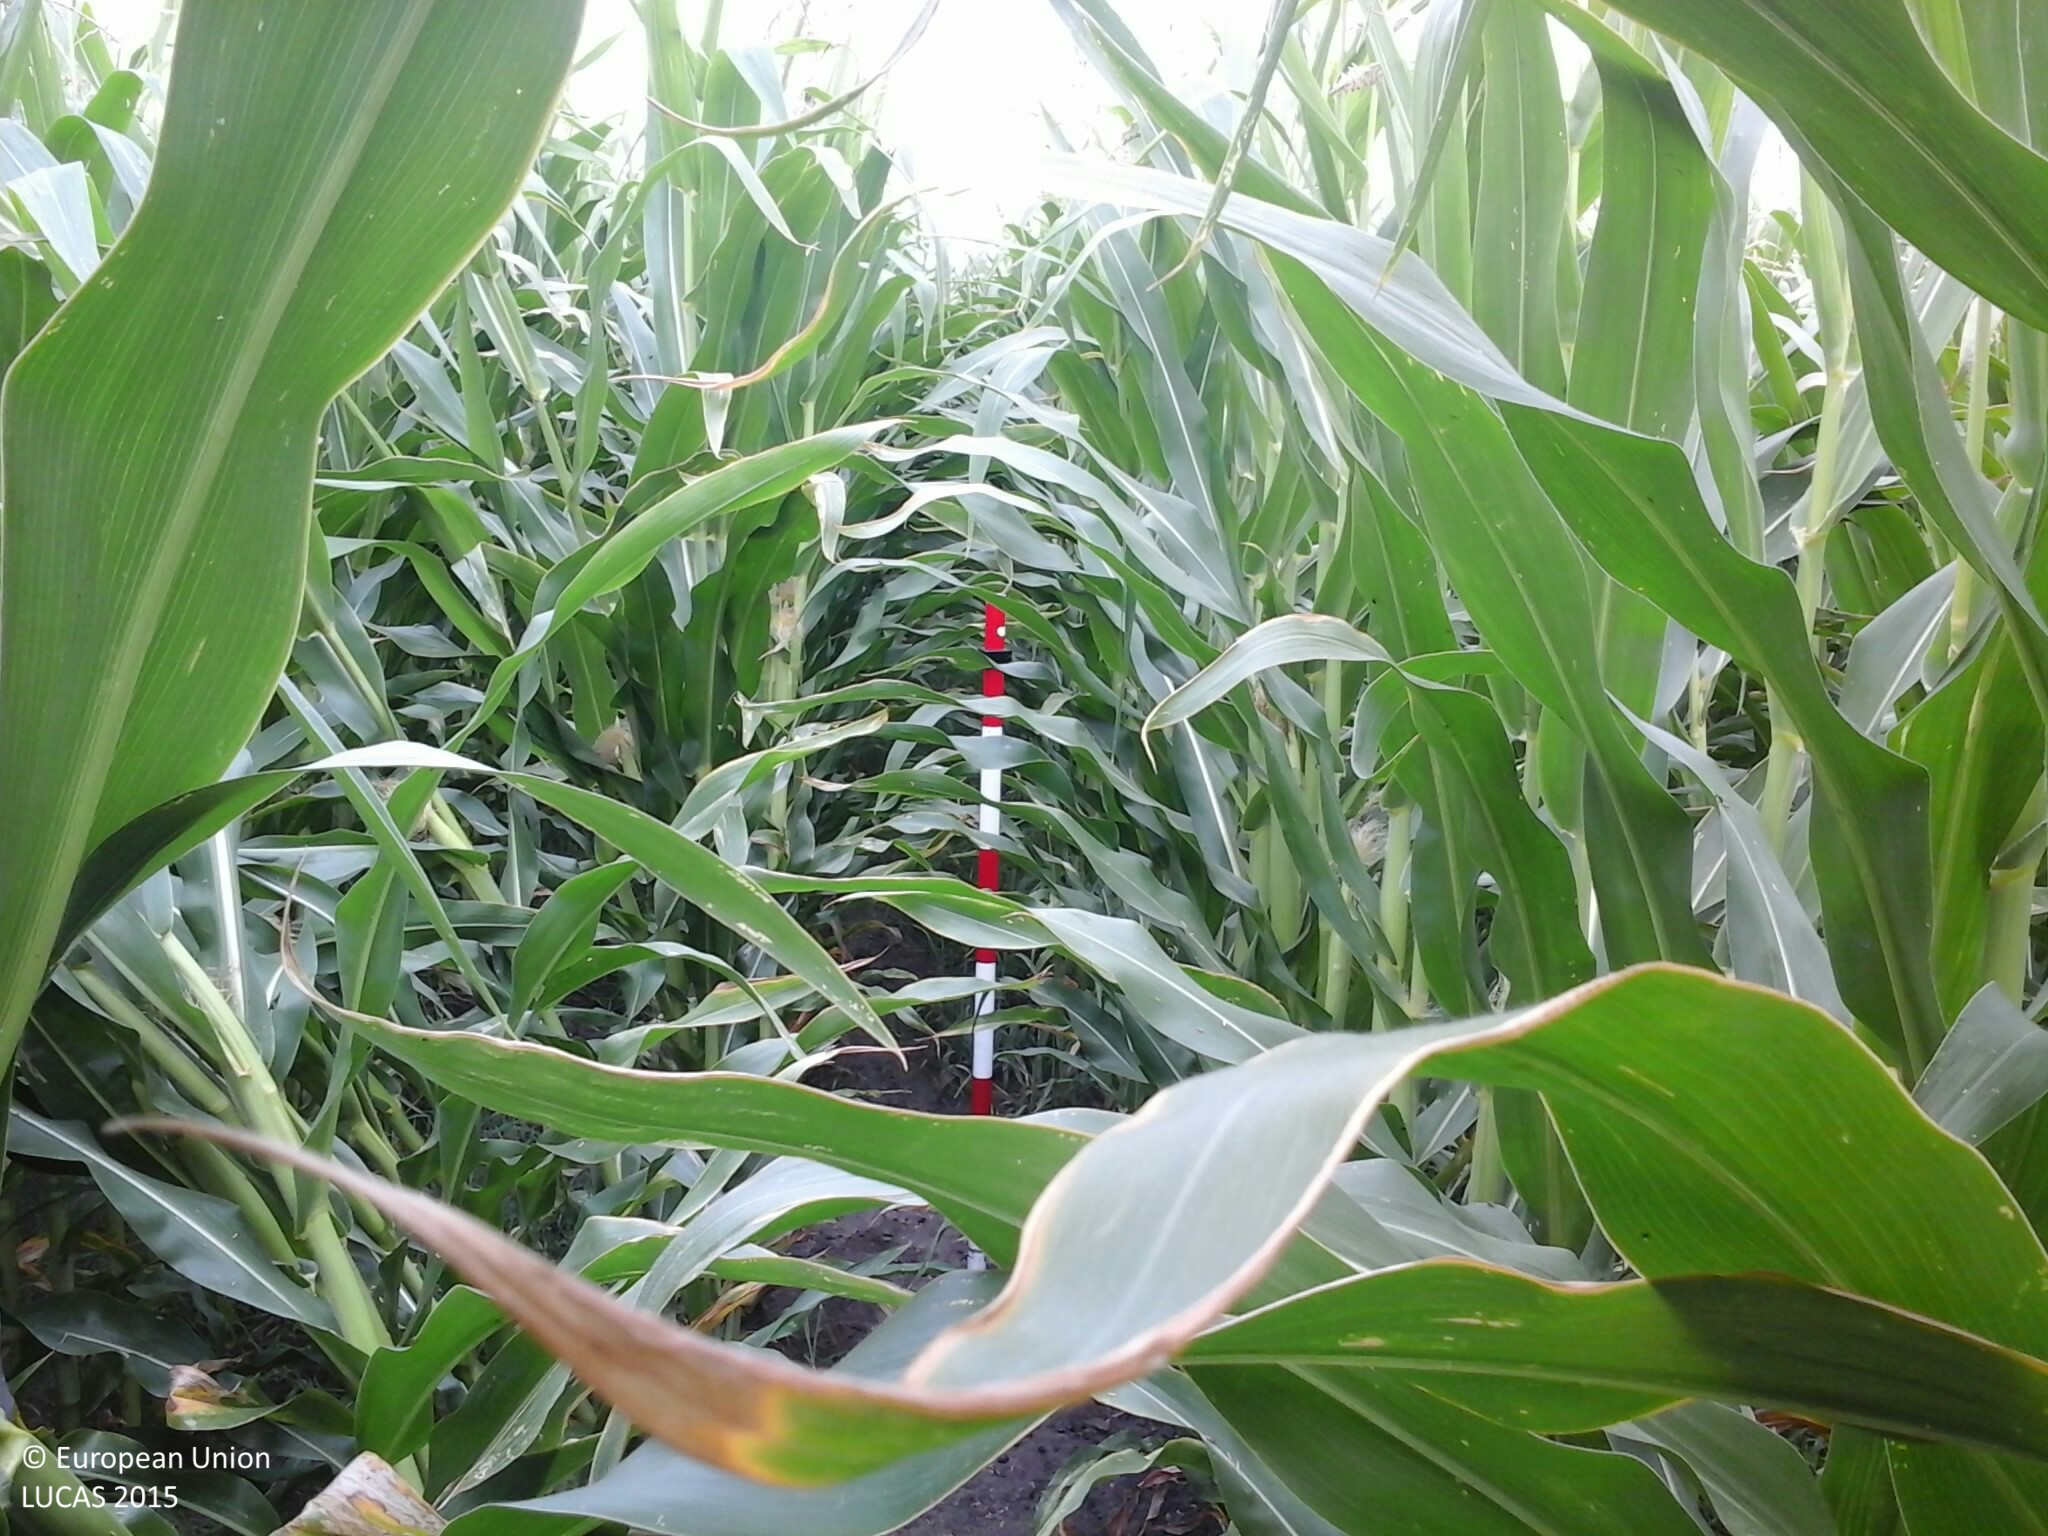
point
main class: Cropland
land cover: Maize
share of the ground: > 75 %
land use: Agriculture (excluding fallow land and kitchen gardens)
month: July
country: HU
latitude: 47.9141
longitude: 22.1362
